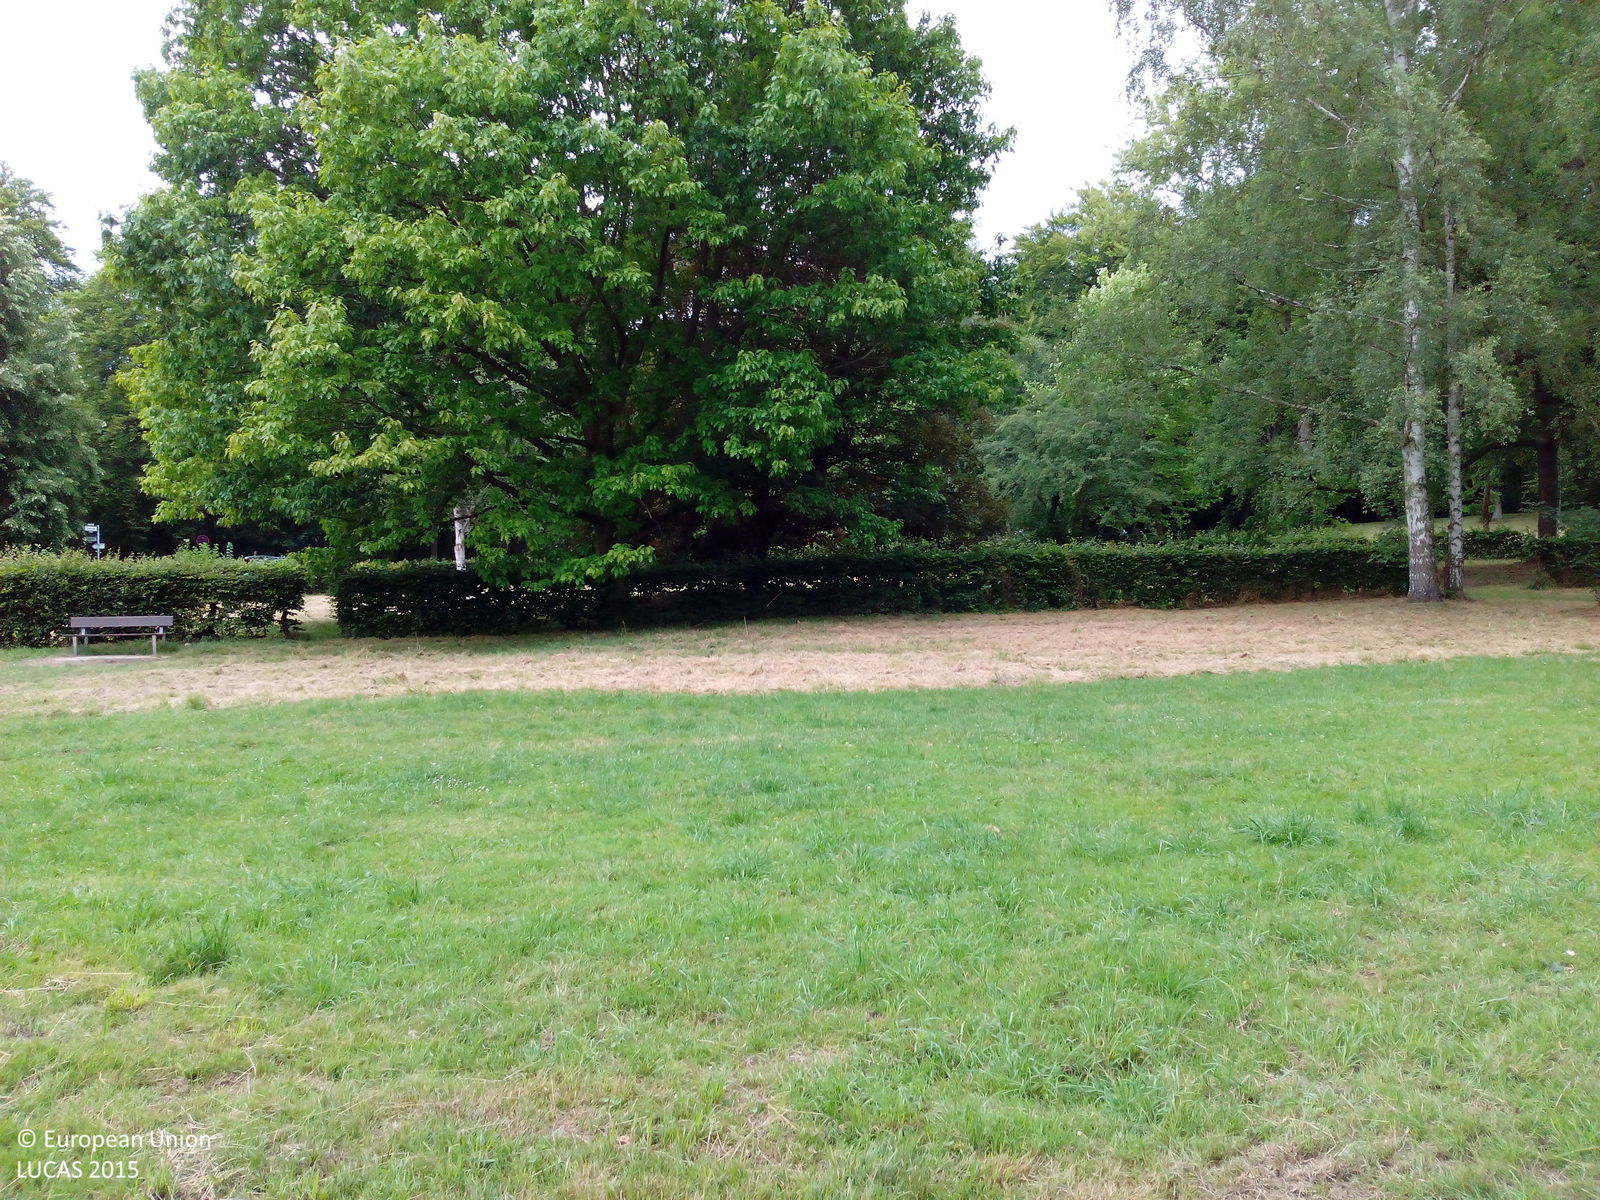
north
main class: Grassland
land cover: Grassland without tree/shrub cover
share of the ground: > 75 %
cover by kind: herbaceous plants 100 %
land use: Community services
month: July
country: DE
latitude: 51.5326
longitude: 9.9568
